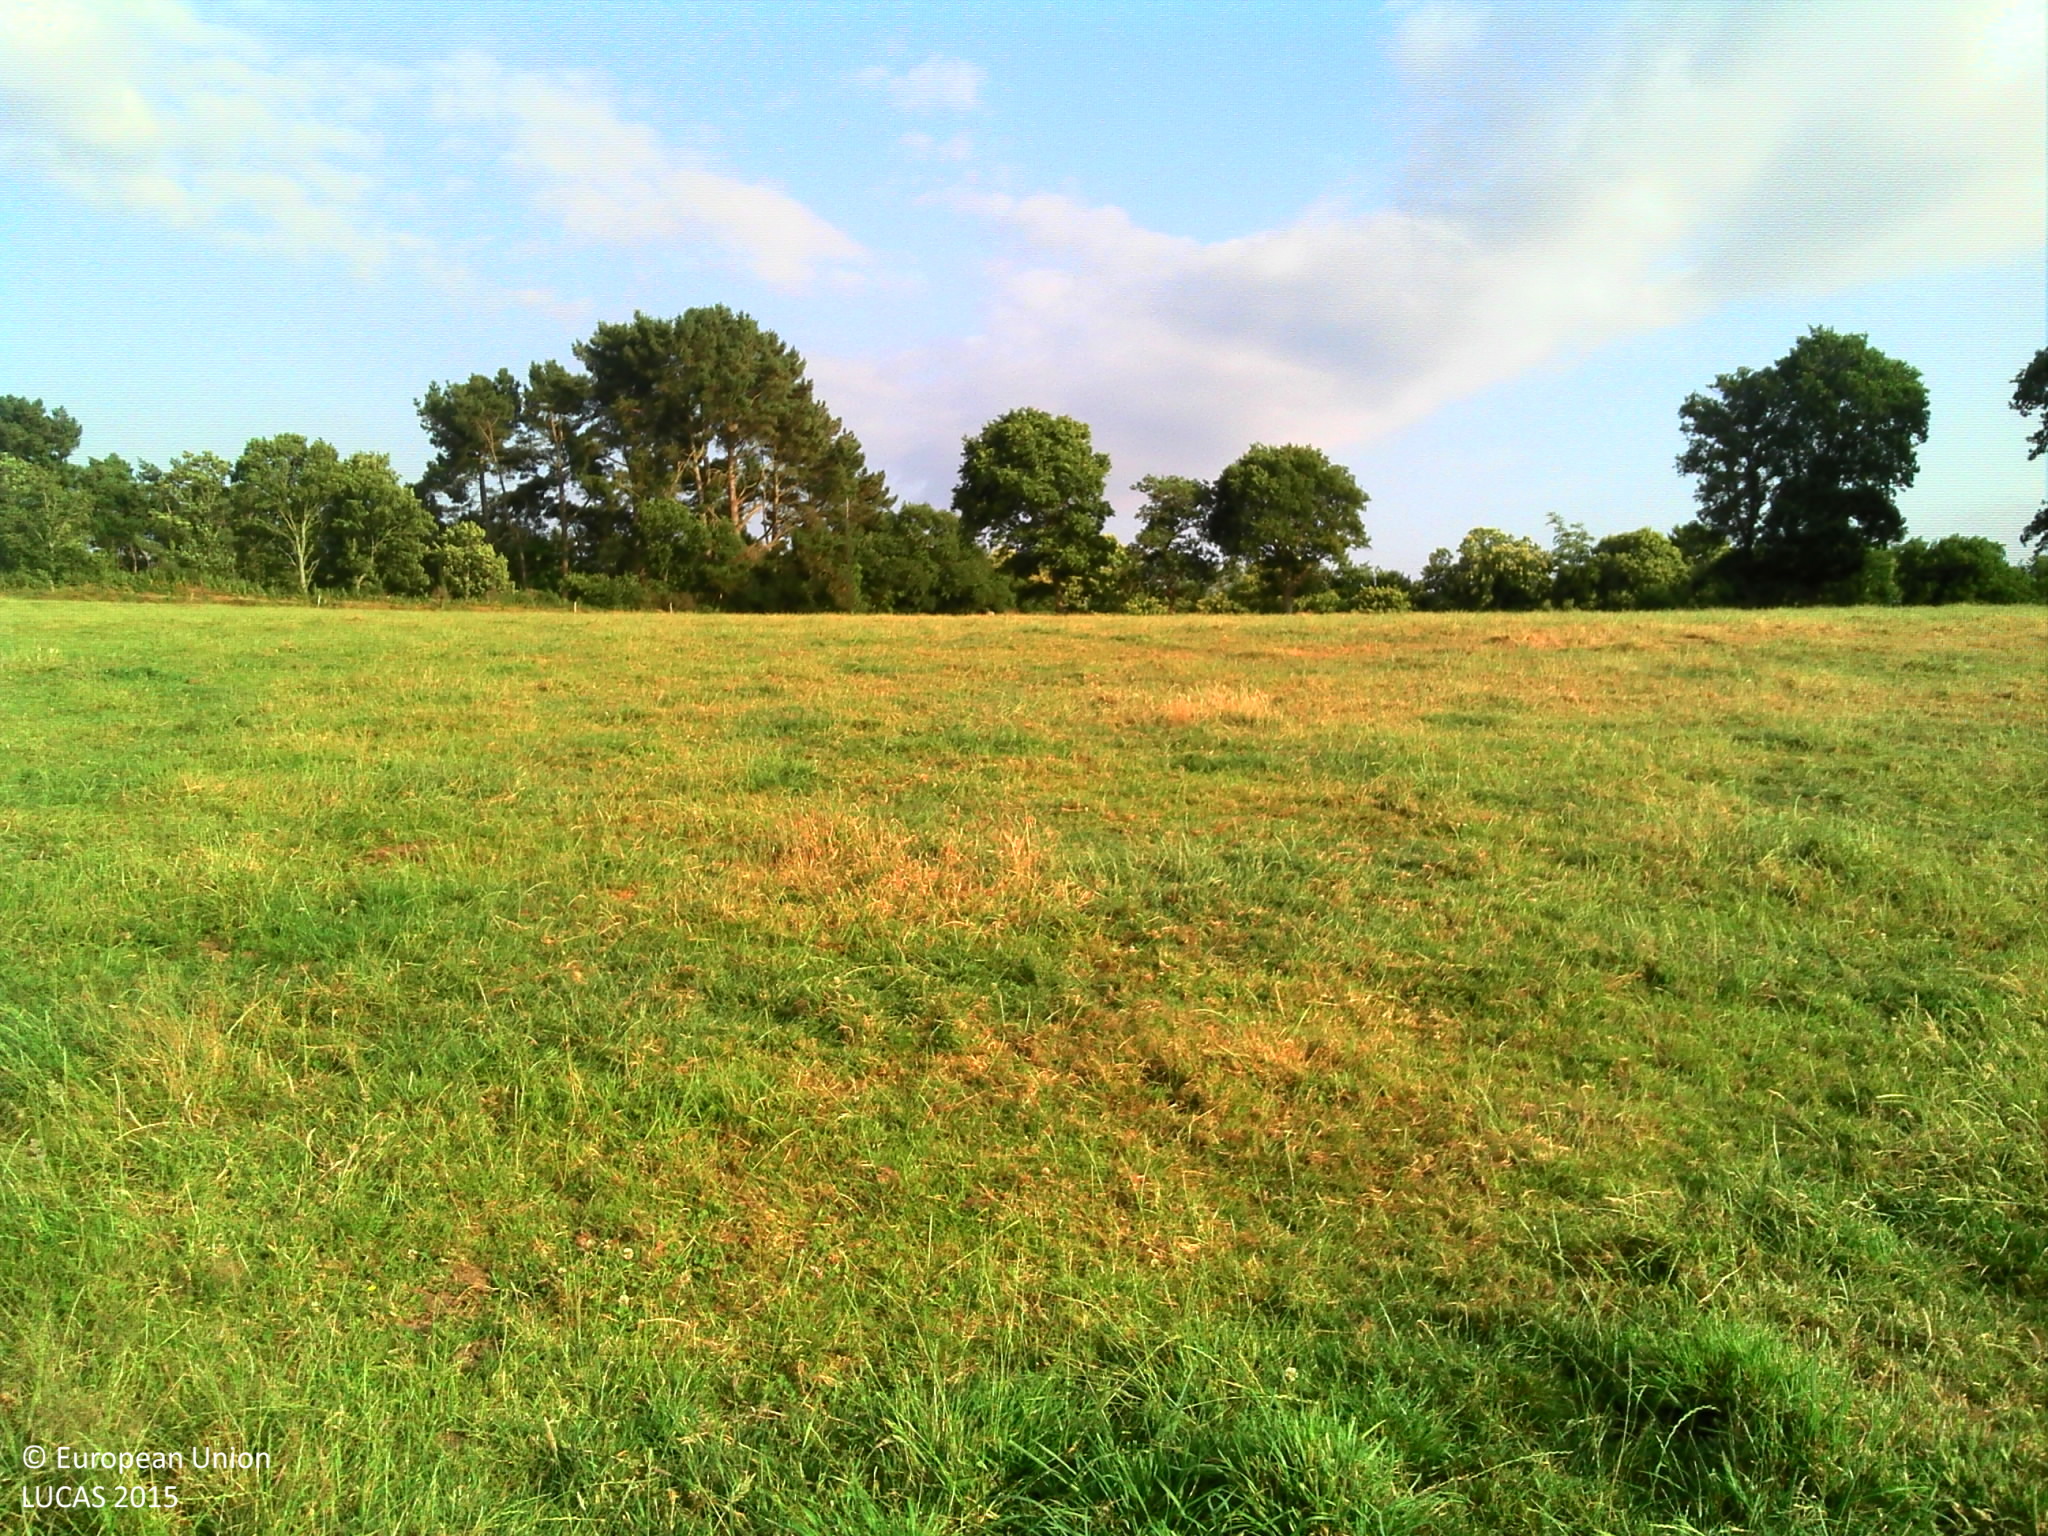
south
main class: Grassland
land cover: Grassland without tree/shrub cover
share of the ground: > 75 %
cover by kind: herbaceous plants 100 %
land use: Agriculture (excluding fallow land and kitchen gardens)
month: July
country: FR
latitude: 48.6885
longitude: -3.4593
